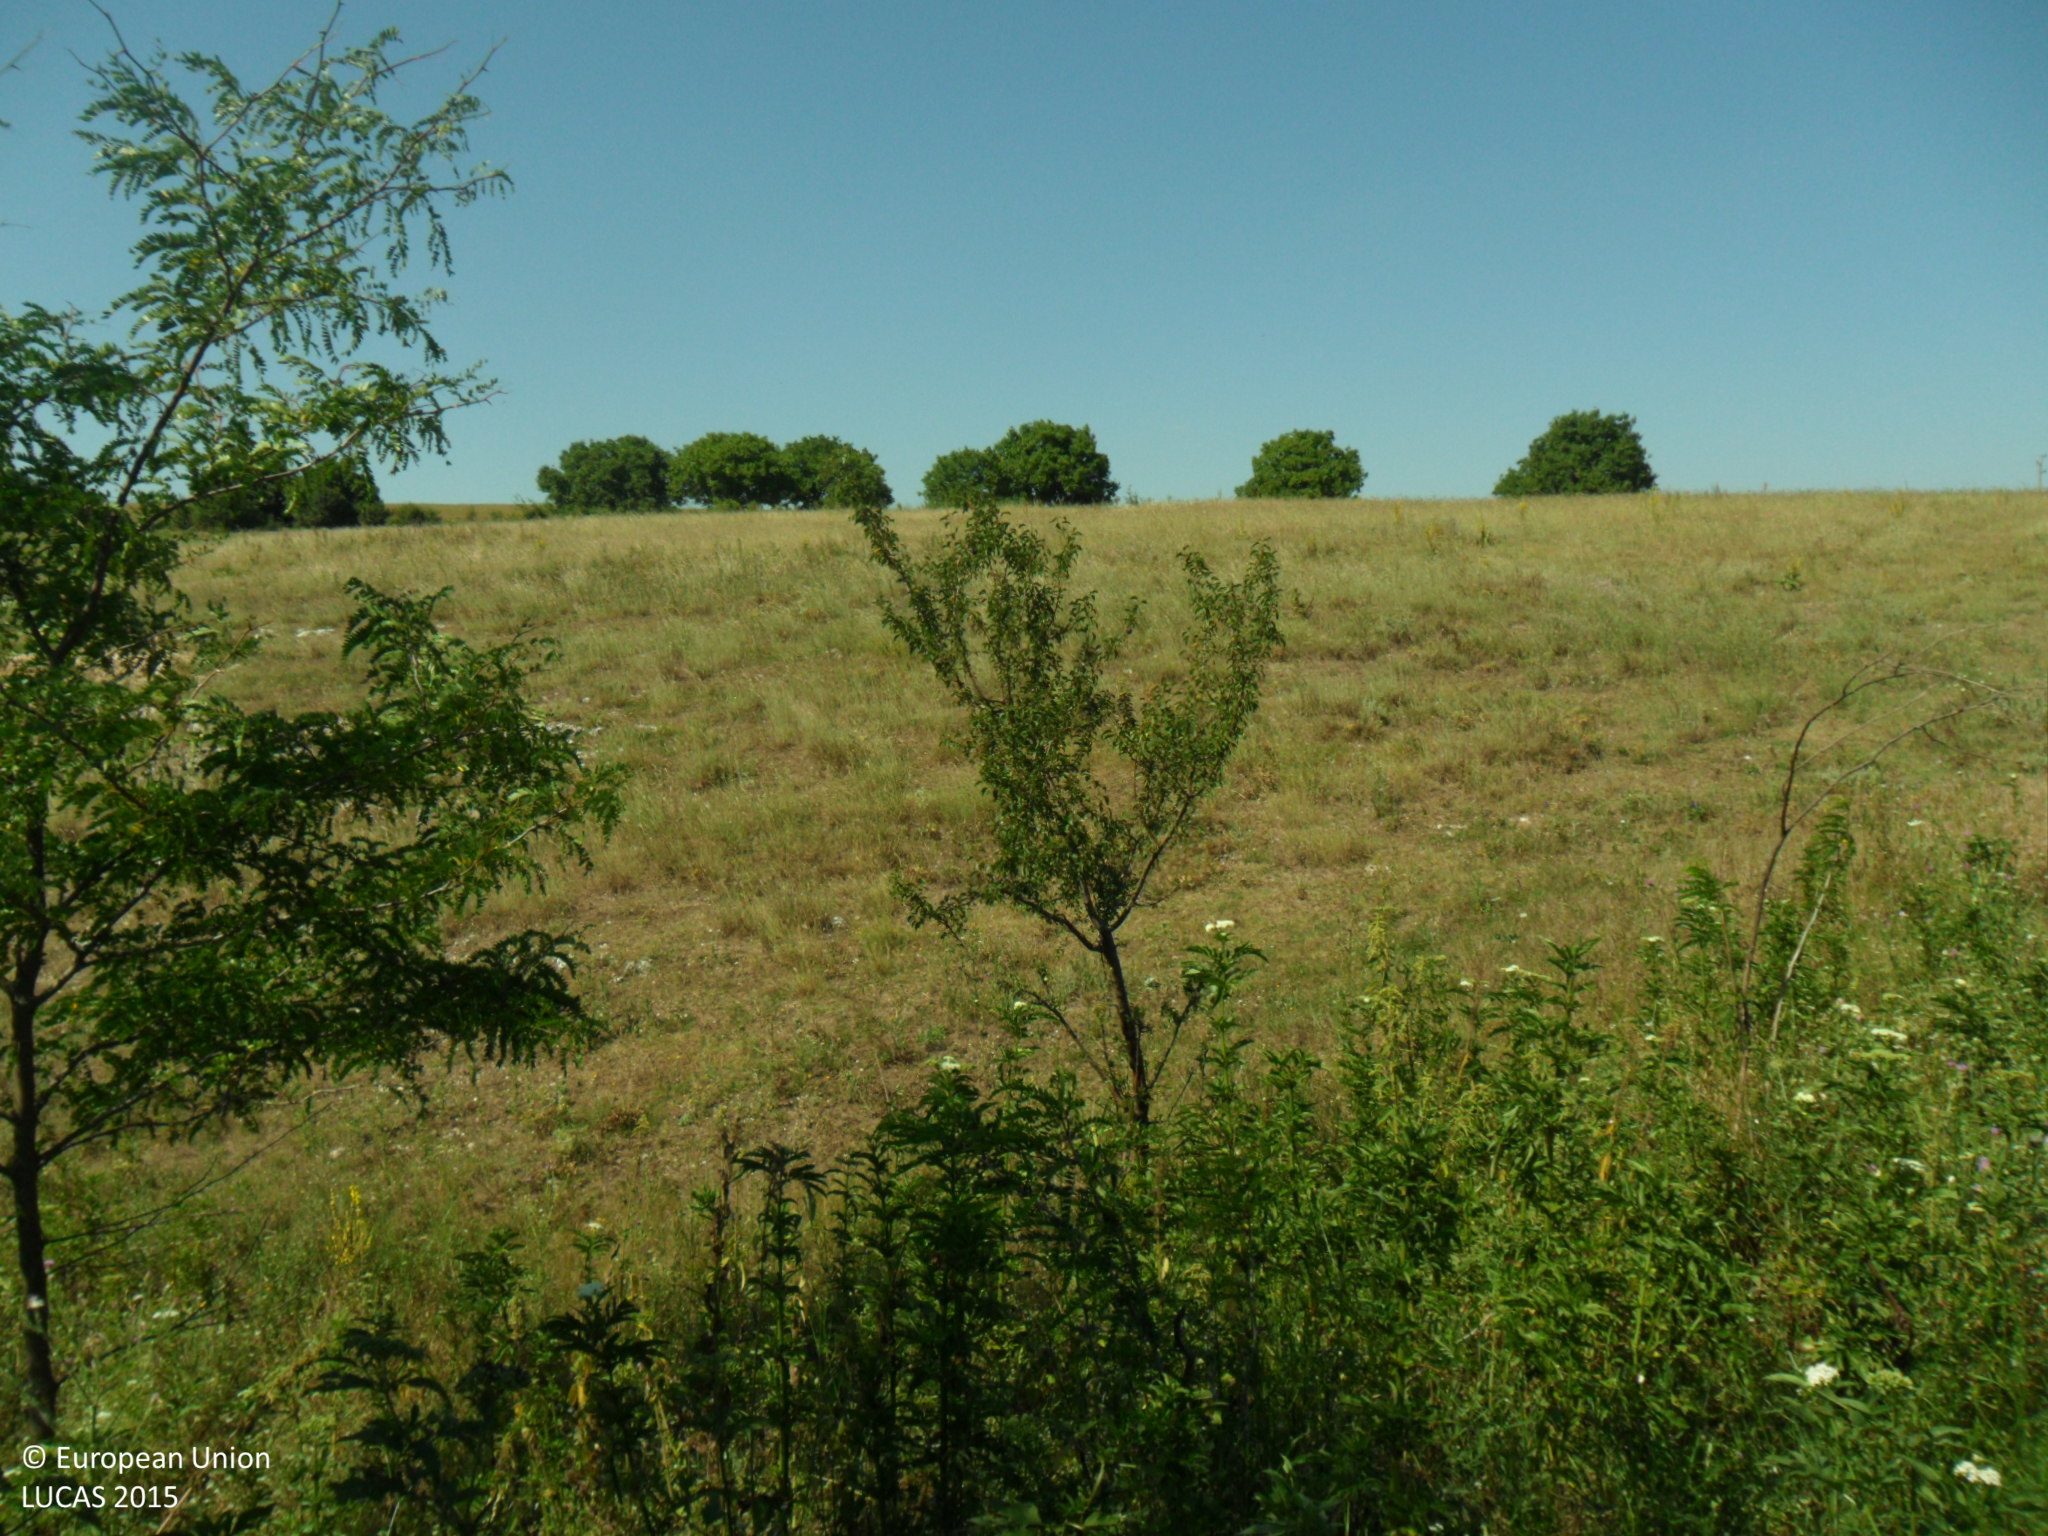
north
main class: Grassland
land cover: Grassland with sparse tree/shrub cover
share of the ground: > 75 %
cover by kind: herbaceous plants 90 %, broadleaved forest trees 5 %, shrubs 5 %
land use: Agriculture (excluding fallow land and kitchen gardens)
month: July
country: BG
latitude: 43.8727
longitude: 26.4469
